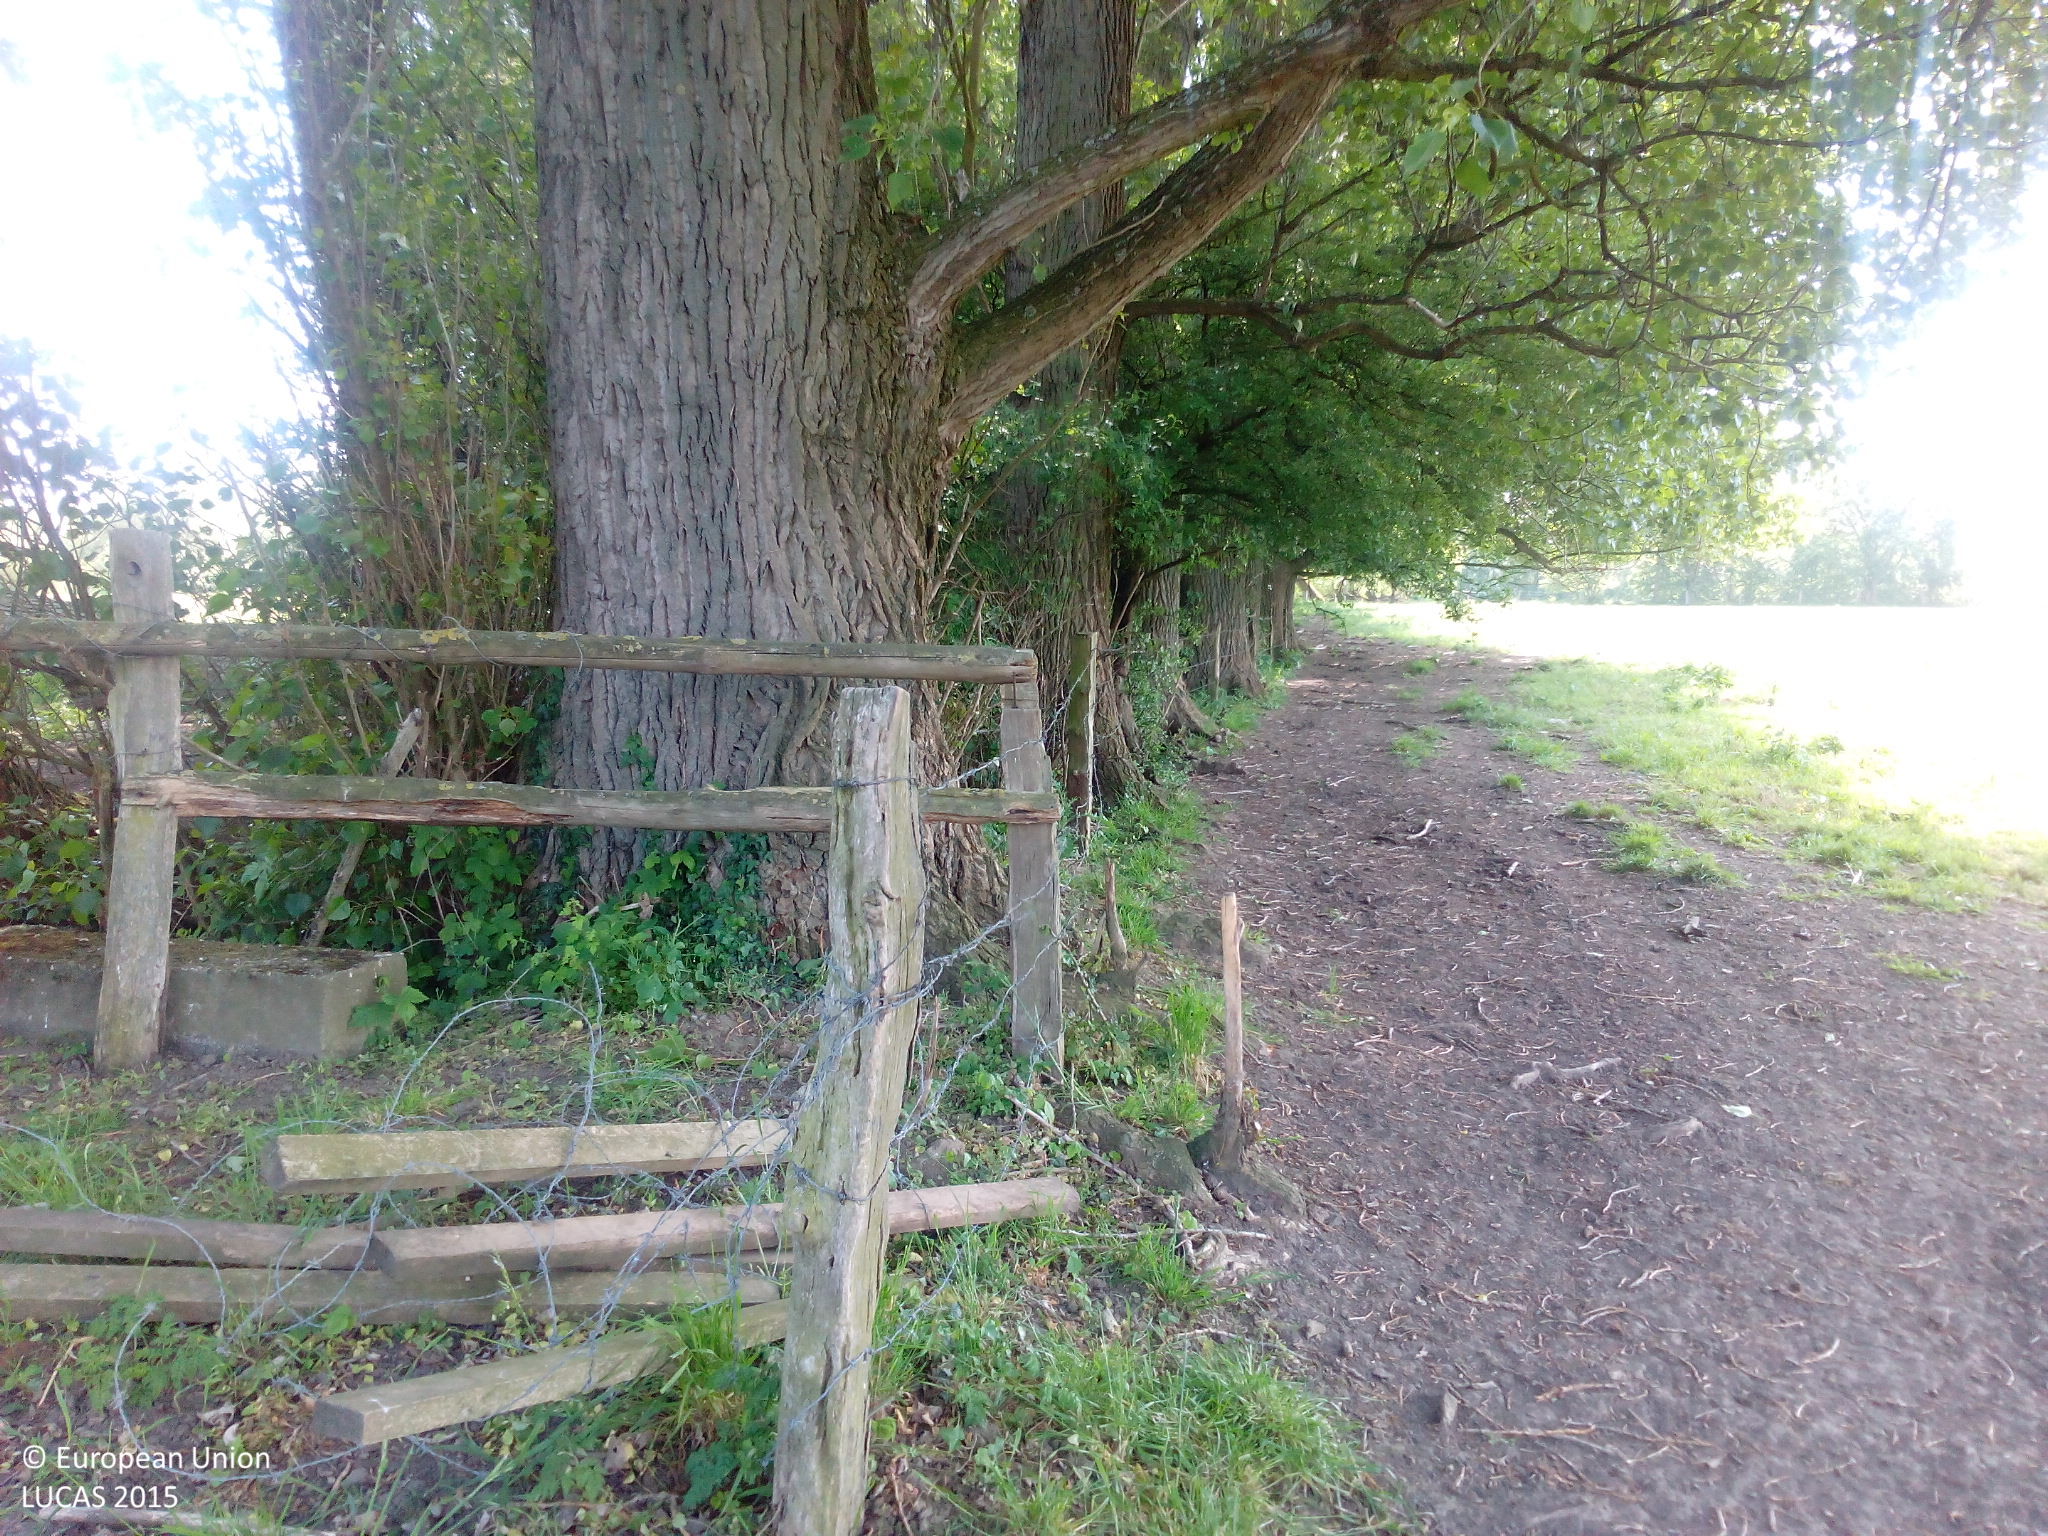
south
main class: Grassland
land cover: Grassland without tree/shrub cover
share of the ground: > 75 %
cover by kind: herbaceous plants 100 %
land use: Agriculture (excluding fallow land and kitchen gardens)
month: May
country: DE
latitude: 51.6947
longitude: 7.9605
